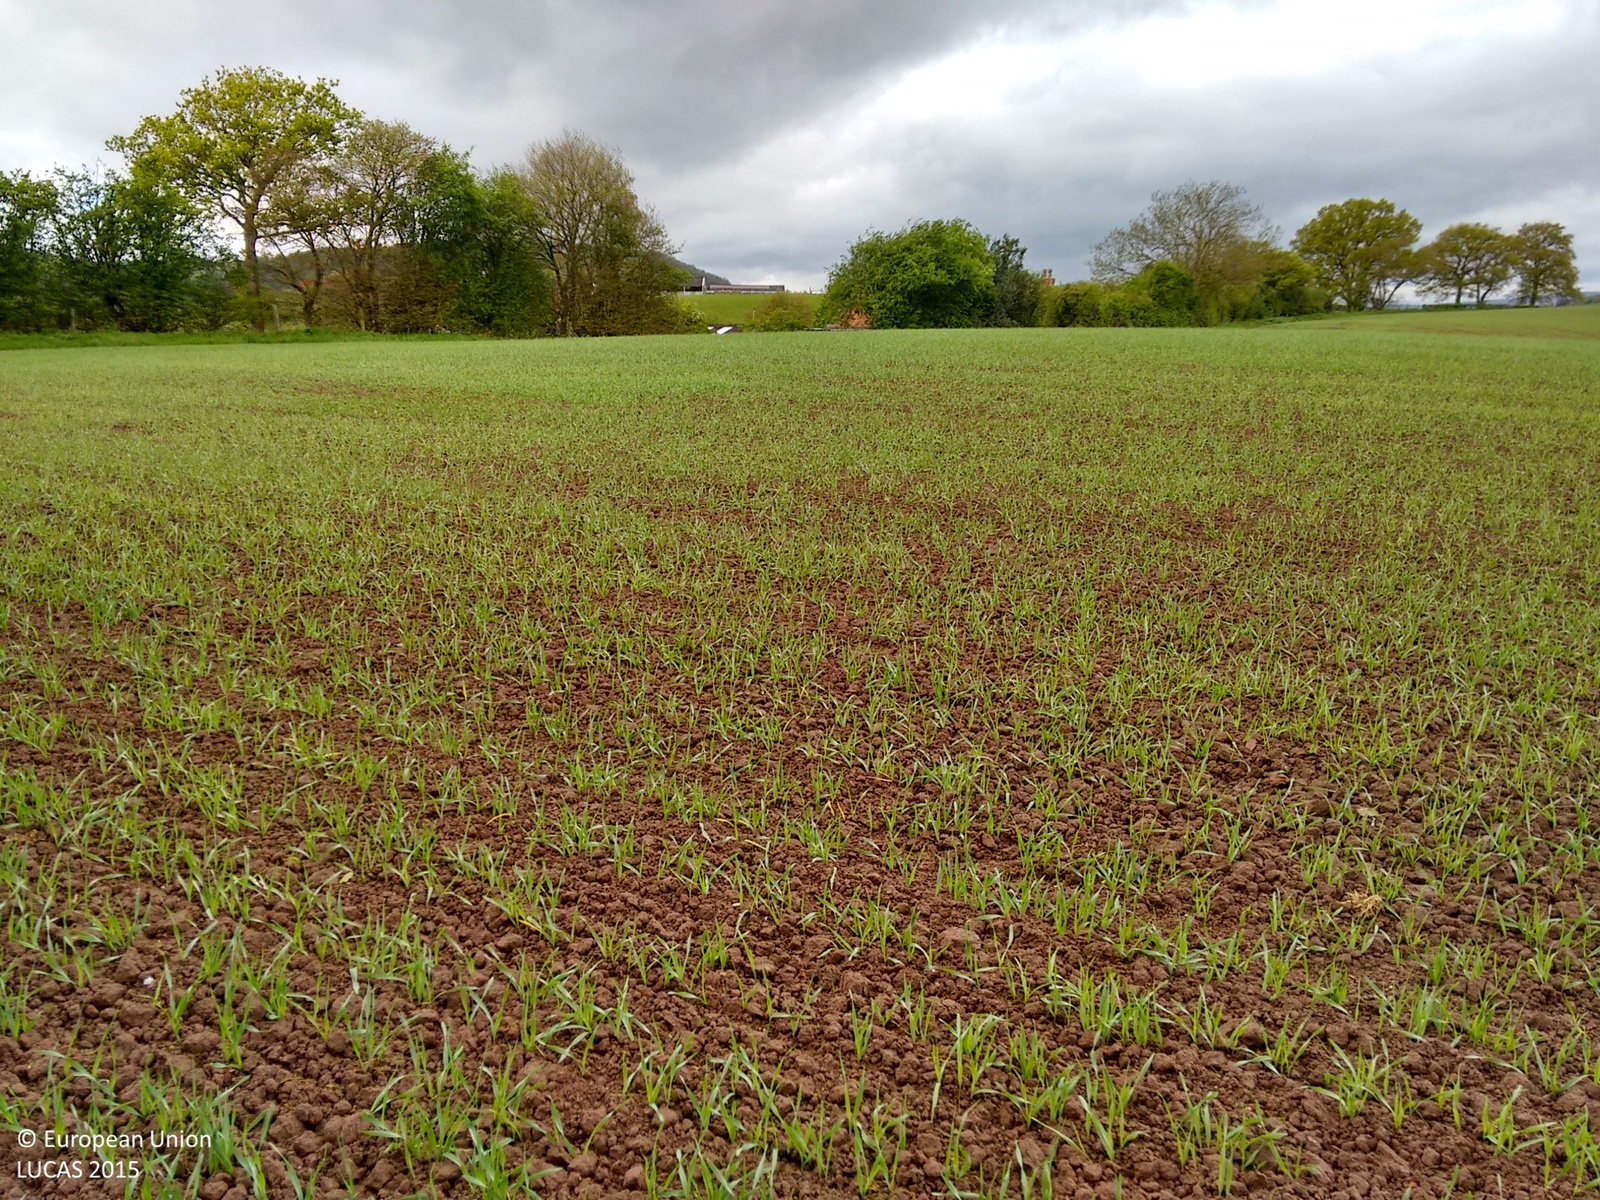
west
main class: Cropland
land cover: Barley
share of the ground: 25 - 50 %
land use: Agriculture (excluding fallow land and kitchen gardens)
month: May
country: GB
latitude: 52.3036
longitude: -2.4281
